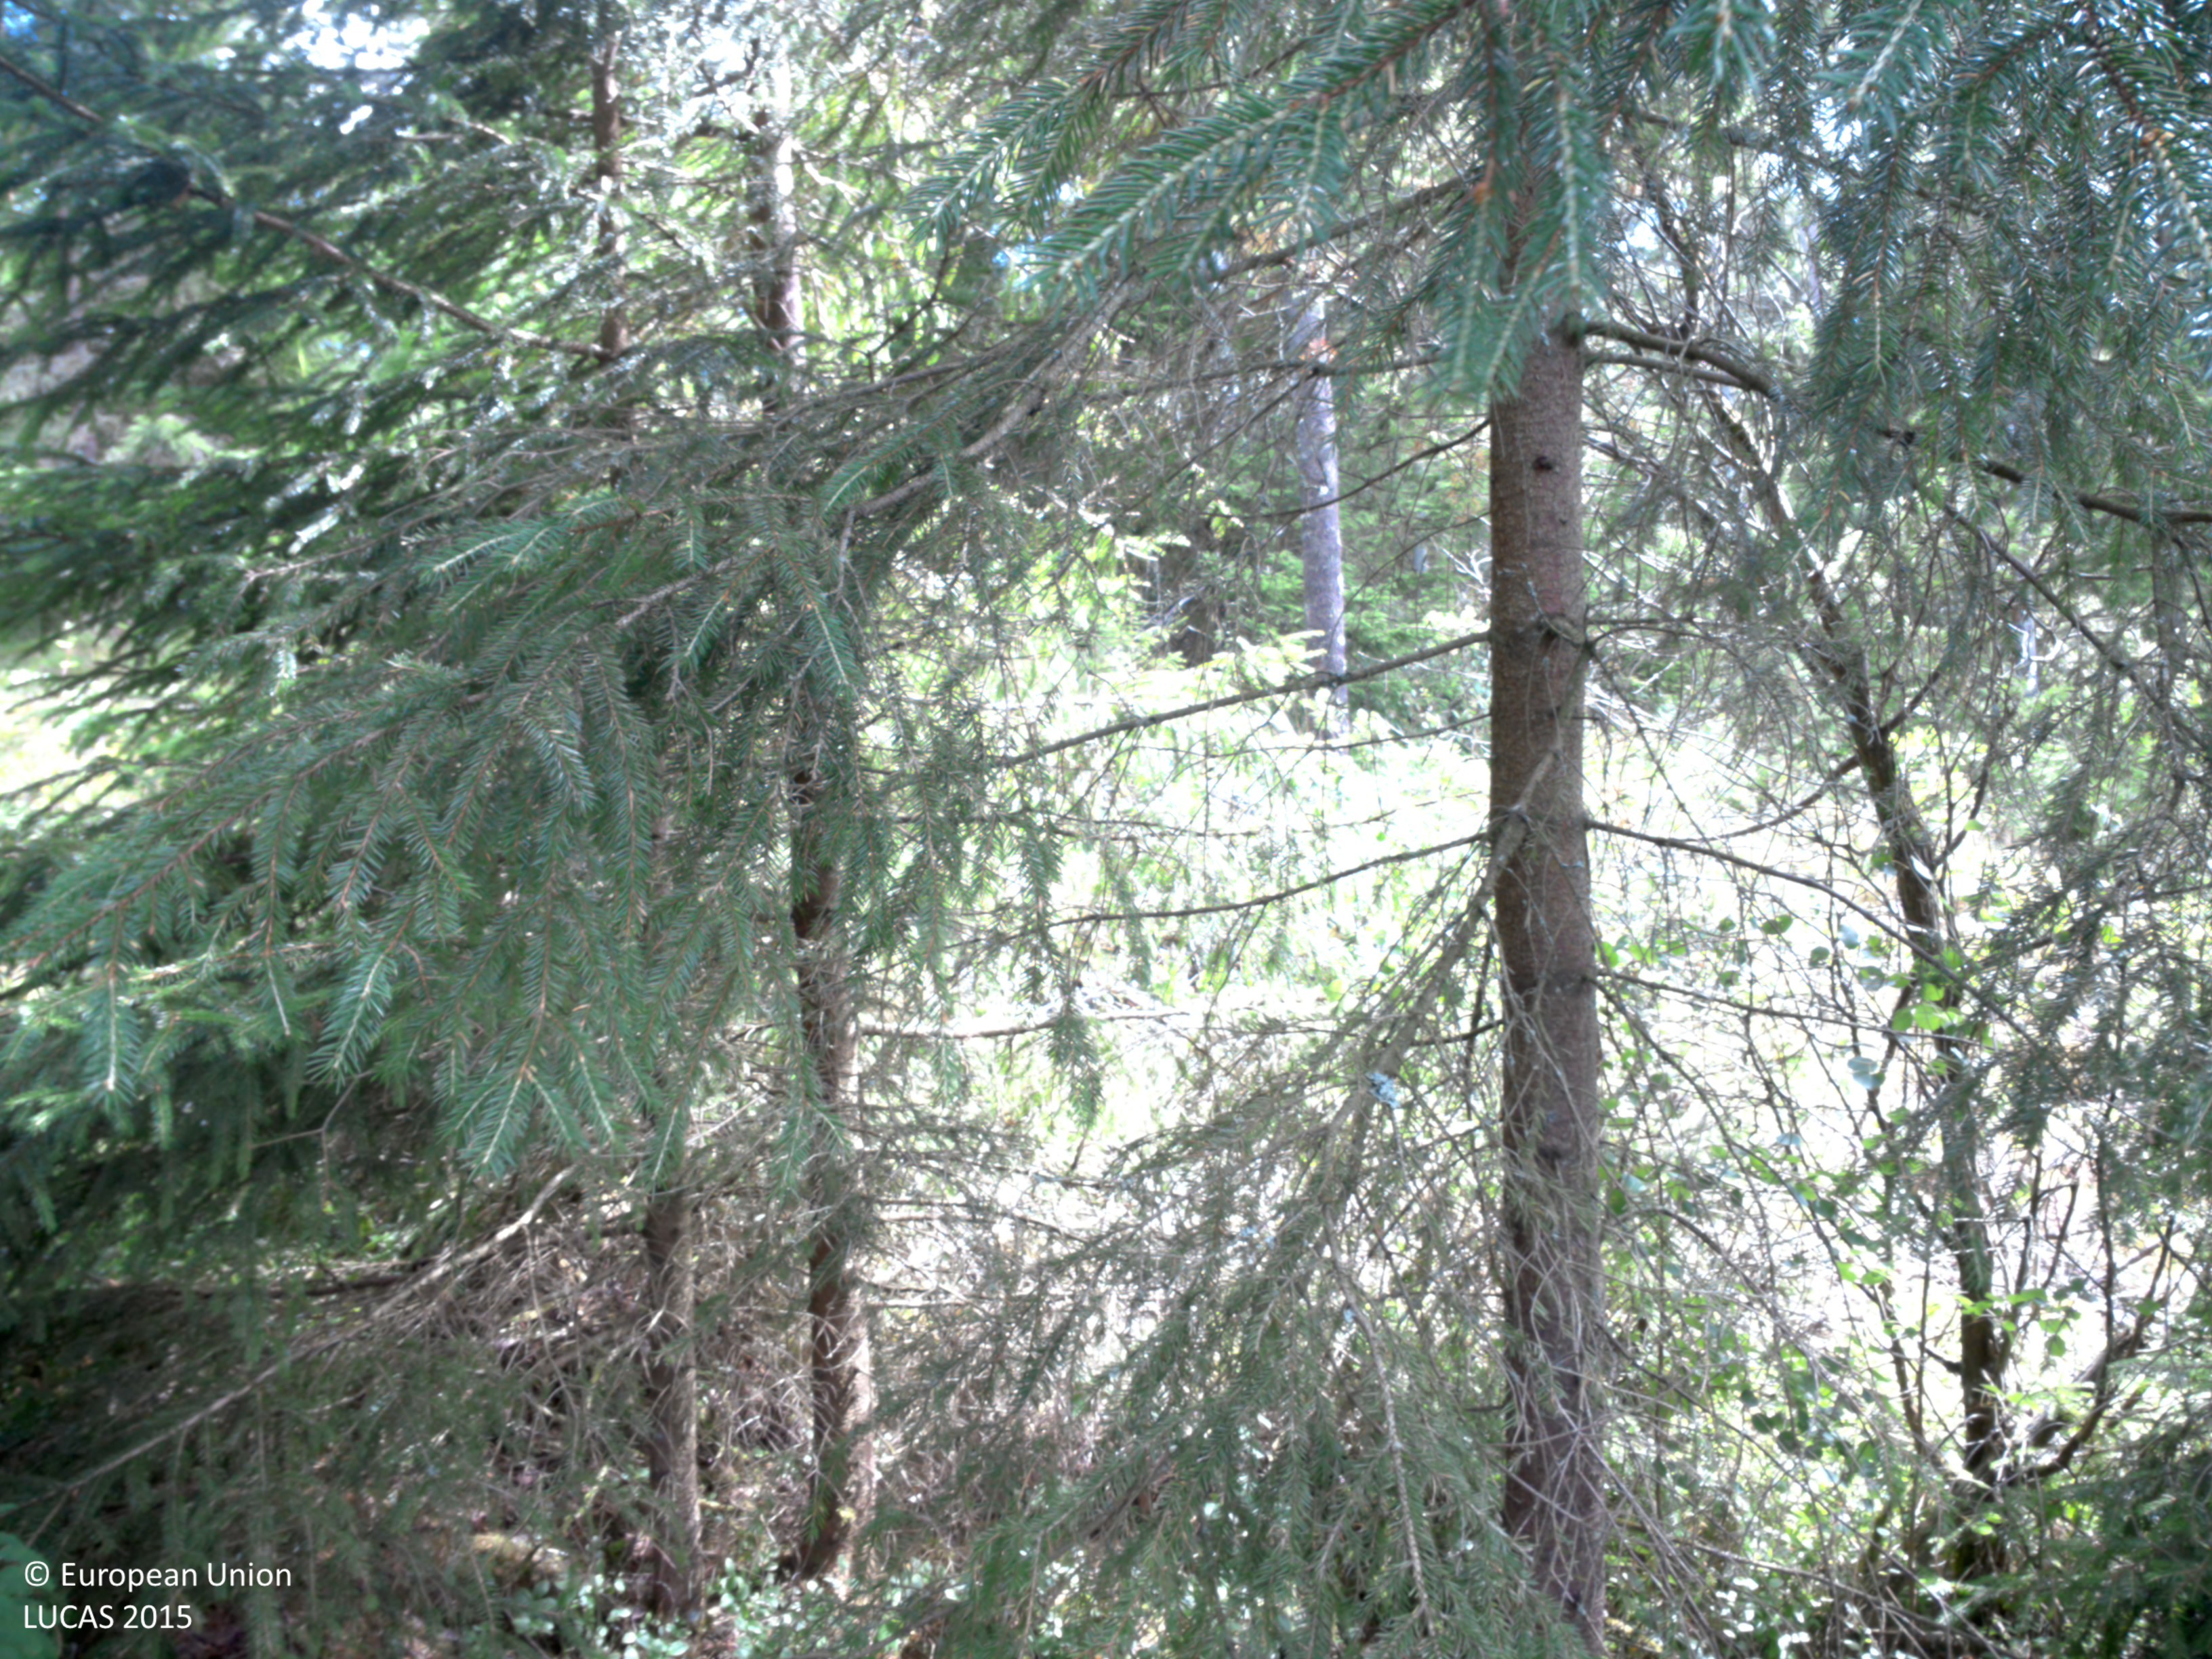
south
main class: Woodland
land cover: Spruce dominated mixed woodland
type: boreal forest
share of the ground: > 75 %
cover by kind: coniferous forest trees 60 %, broadleaved forest trees 20 %, herbaceous plants 10 %, lichens and mosses 10 %
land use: Forestry
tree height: > 5 m
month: July
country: SE
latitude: 58.5663
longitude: 11.8699
